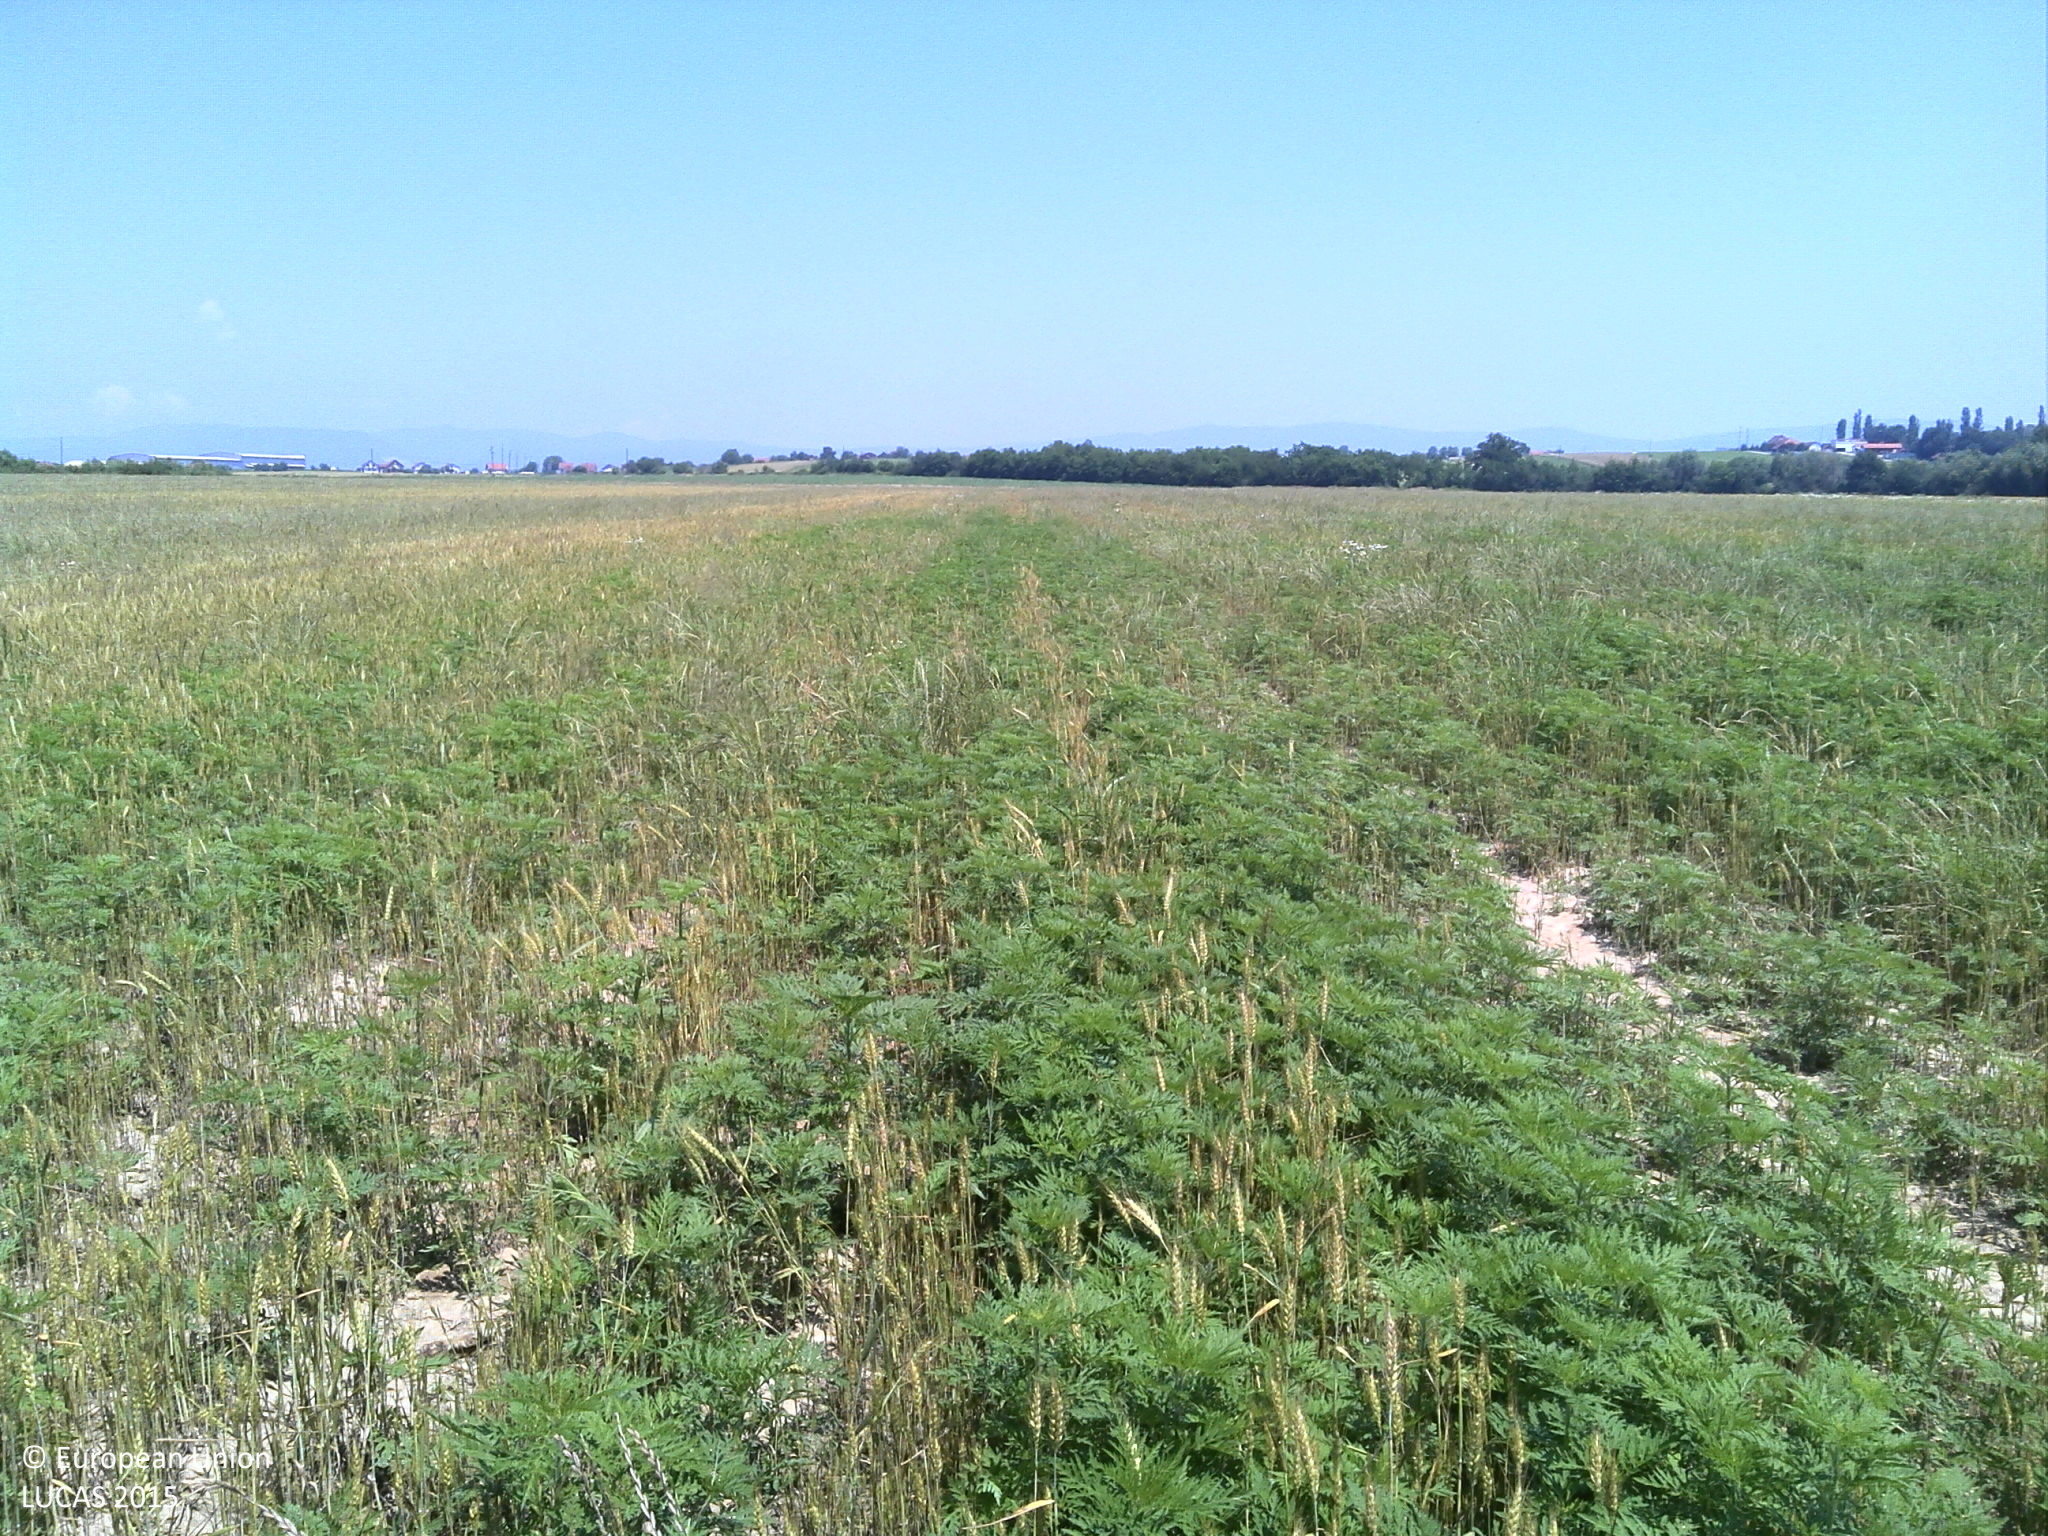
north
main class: Cropland
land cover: Barley
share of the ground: > 75 %
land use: Agriculture (excluding fallow land and kitchen gardens)
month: June
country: HR
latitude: 45.3498
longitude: 17.6983
